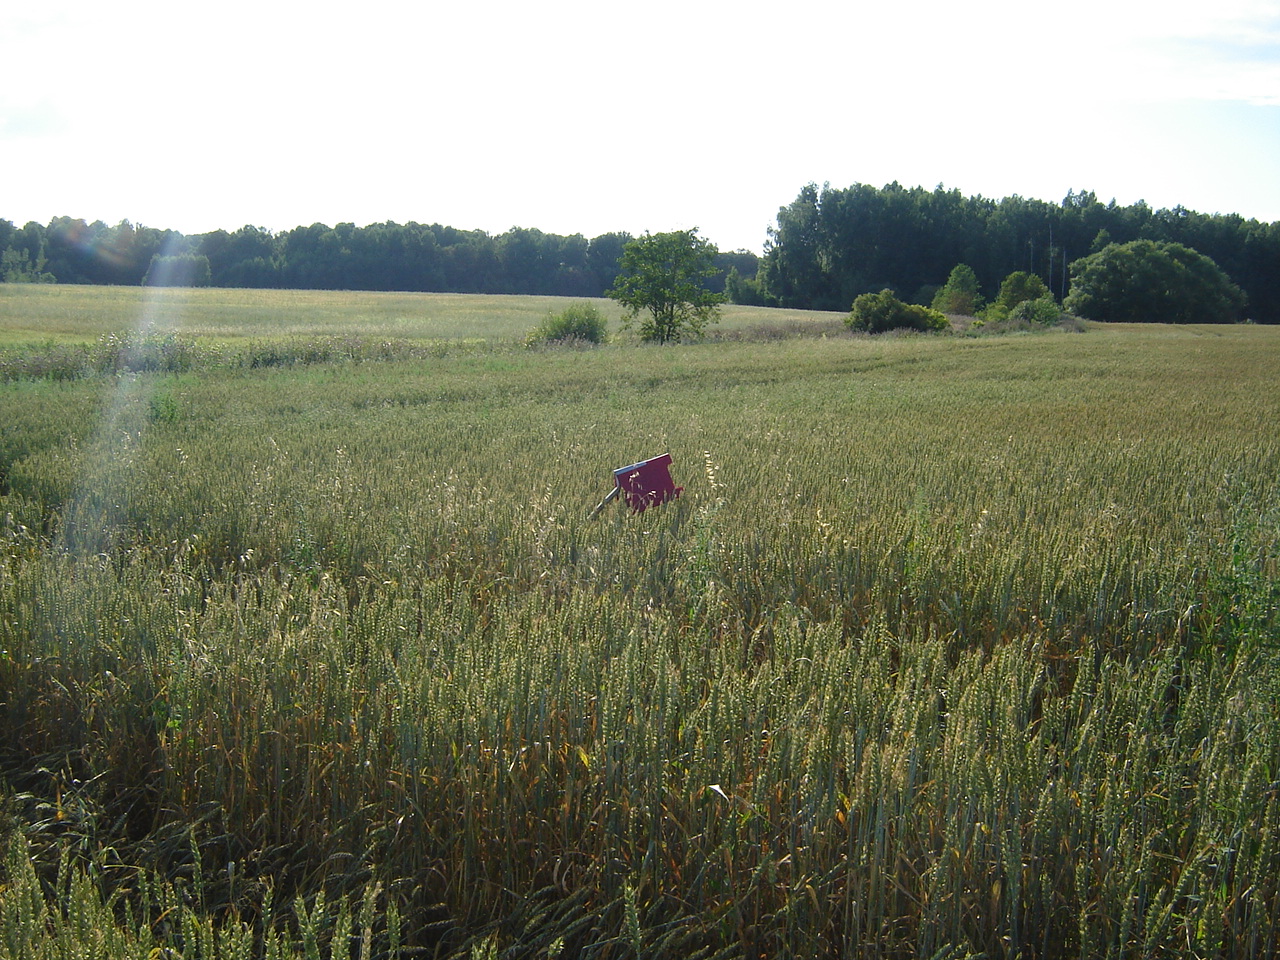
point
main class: Cropland
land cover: Common wheat
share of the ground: > 75 %
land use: Agriculture (excluding fallow land and kitchen gardens)
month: July
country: LT
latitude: 55.3323
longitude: 24.7186
